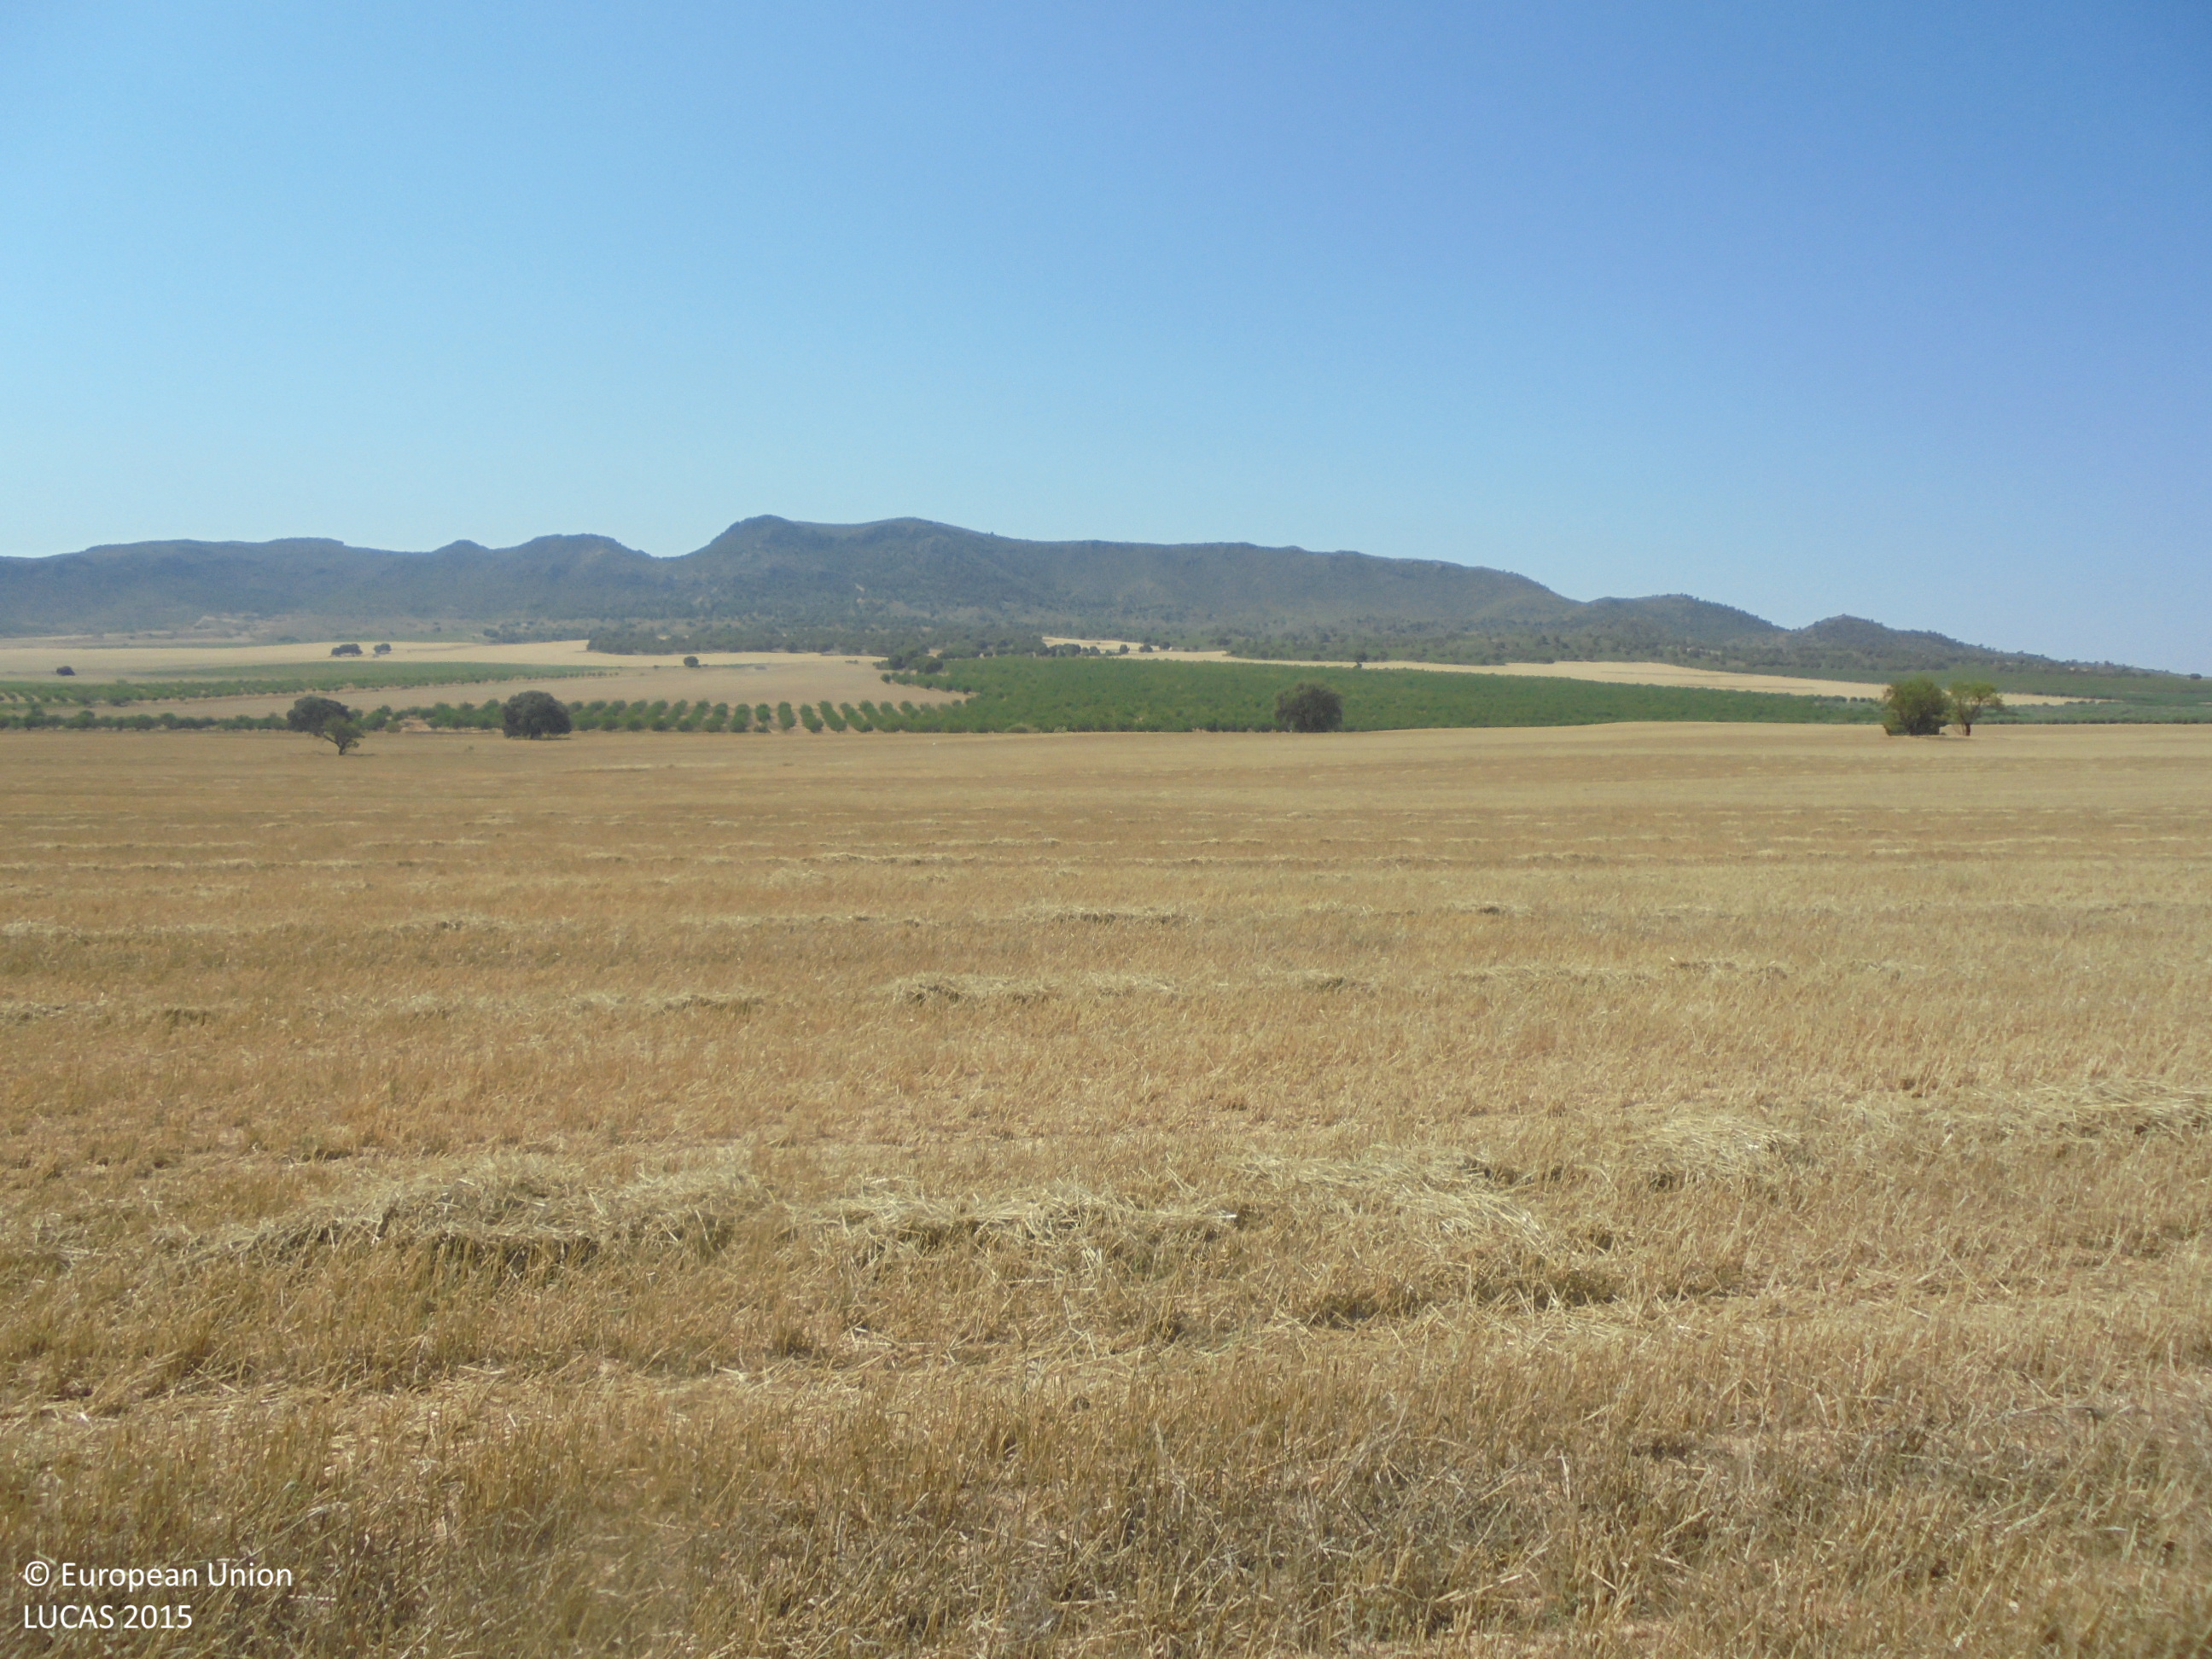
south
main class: Cropland
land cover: Barley
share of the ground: < 10 %
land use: Agriculture (excluding fallow land and kitchen gardens)
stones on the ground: 25 - 50 %
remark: Harvested field
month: July
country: ES
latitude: 38.6698
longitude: -1.5453
